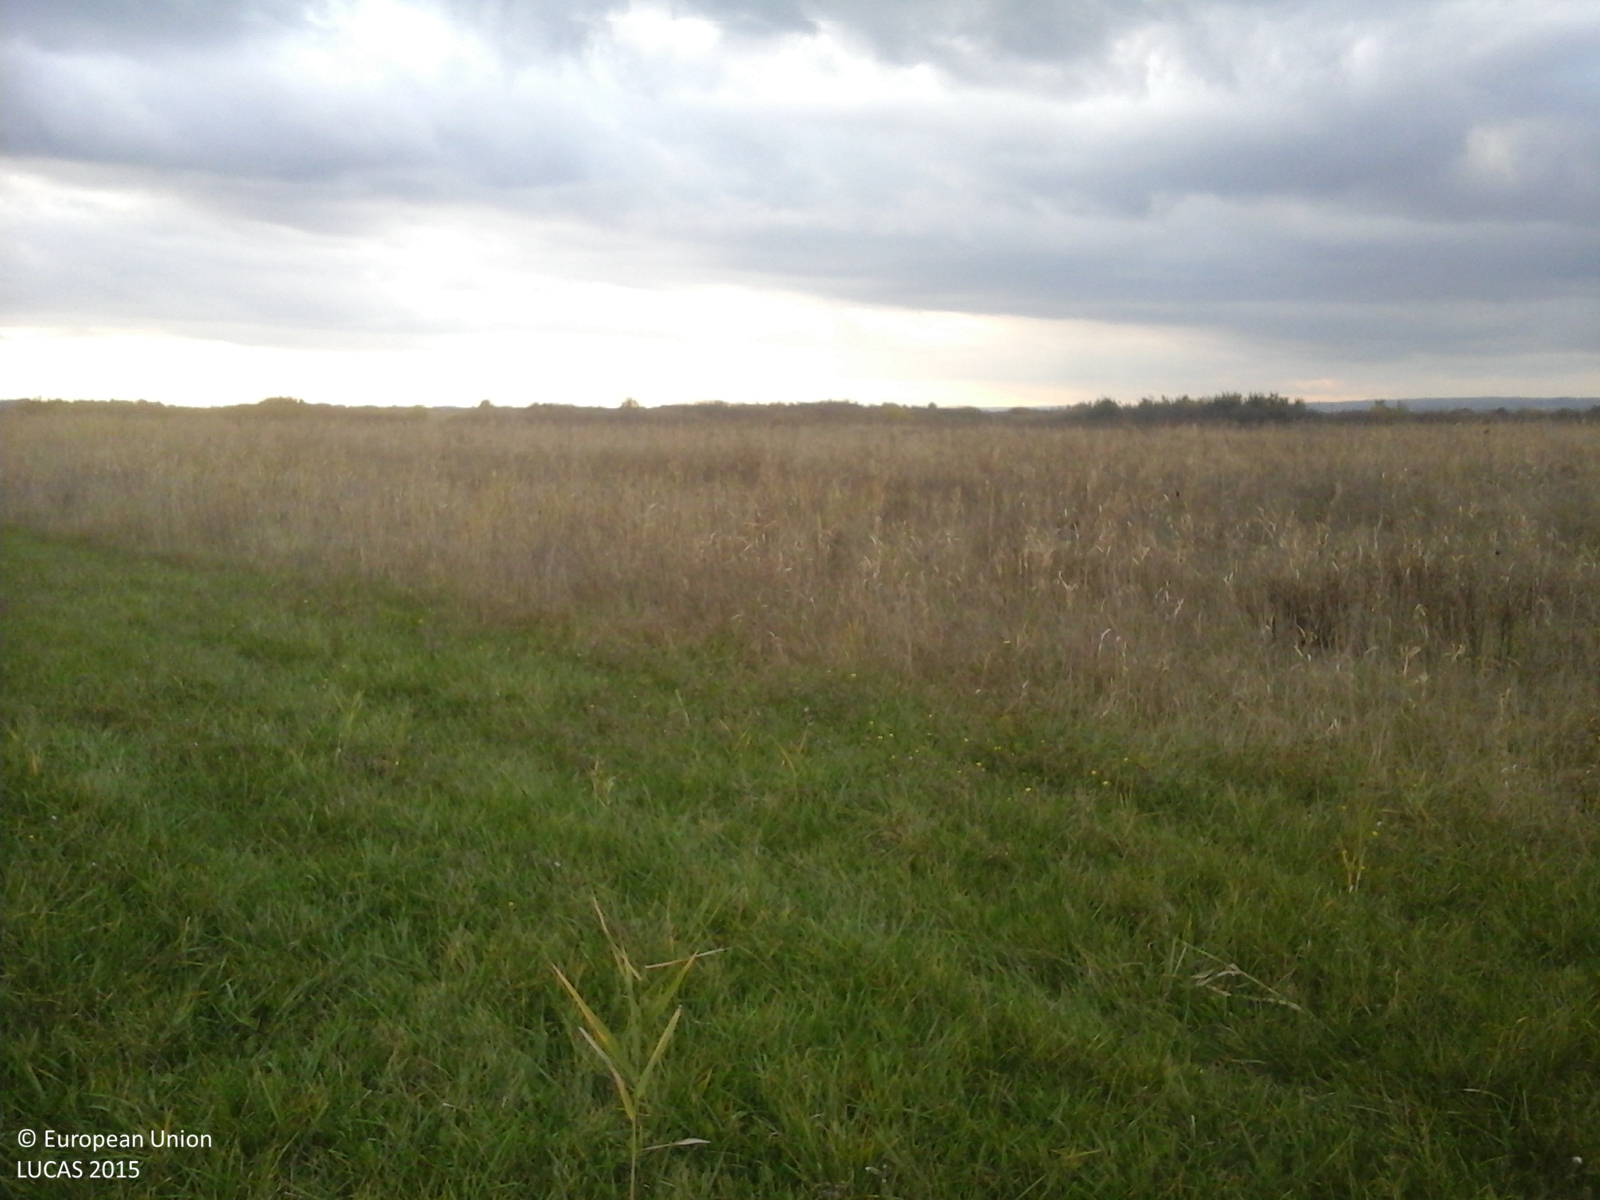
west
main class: Grassland
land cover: Grassland without tree/shrub cover
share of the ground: > 75 %
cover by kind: herbaceous plants 100 %
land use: Agriculture (excluding fallow land and kitchen gardens)
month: October
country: RO
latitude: 44.9025
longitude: 25.6121
